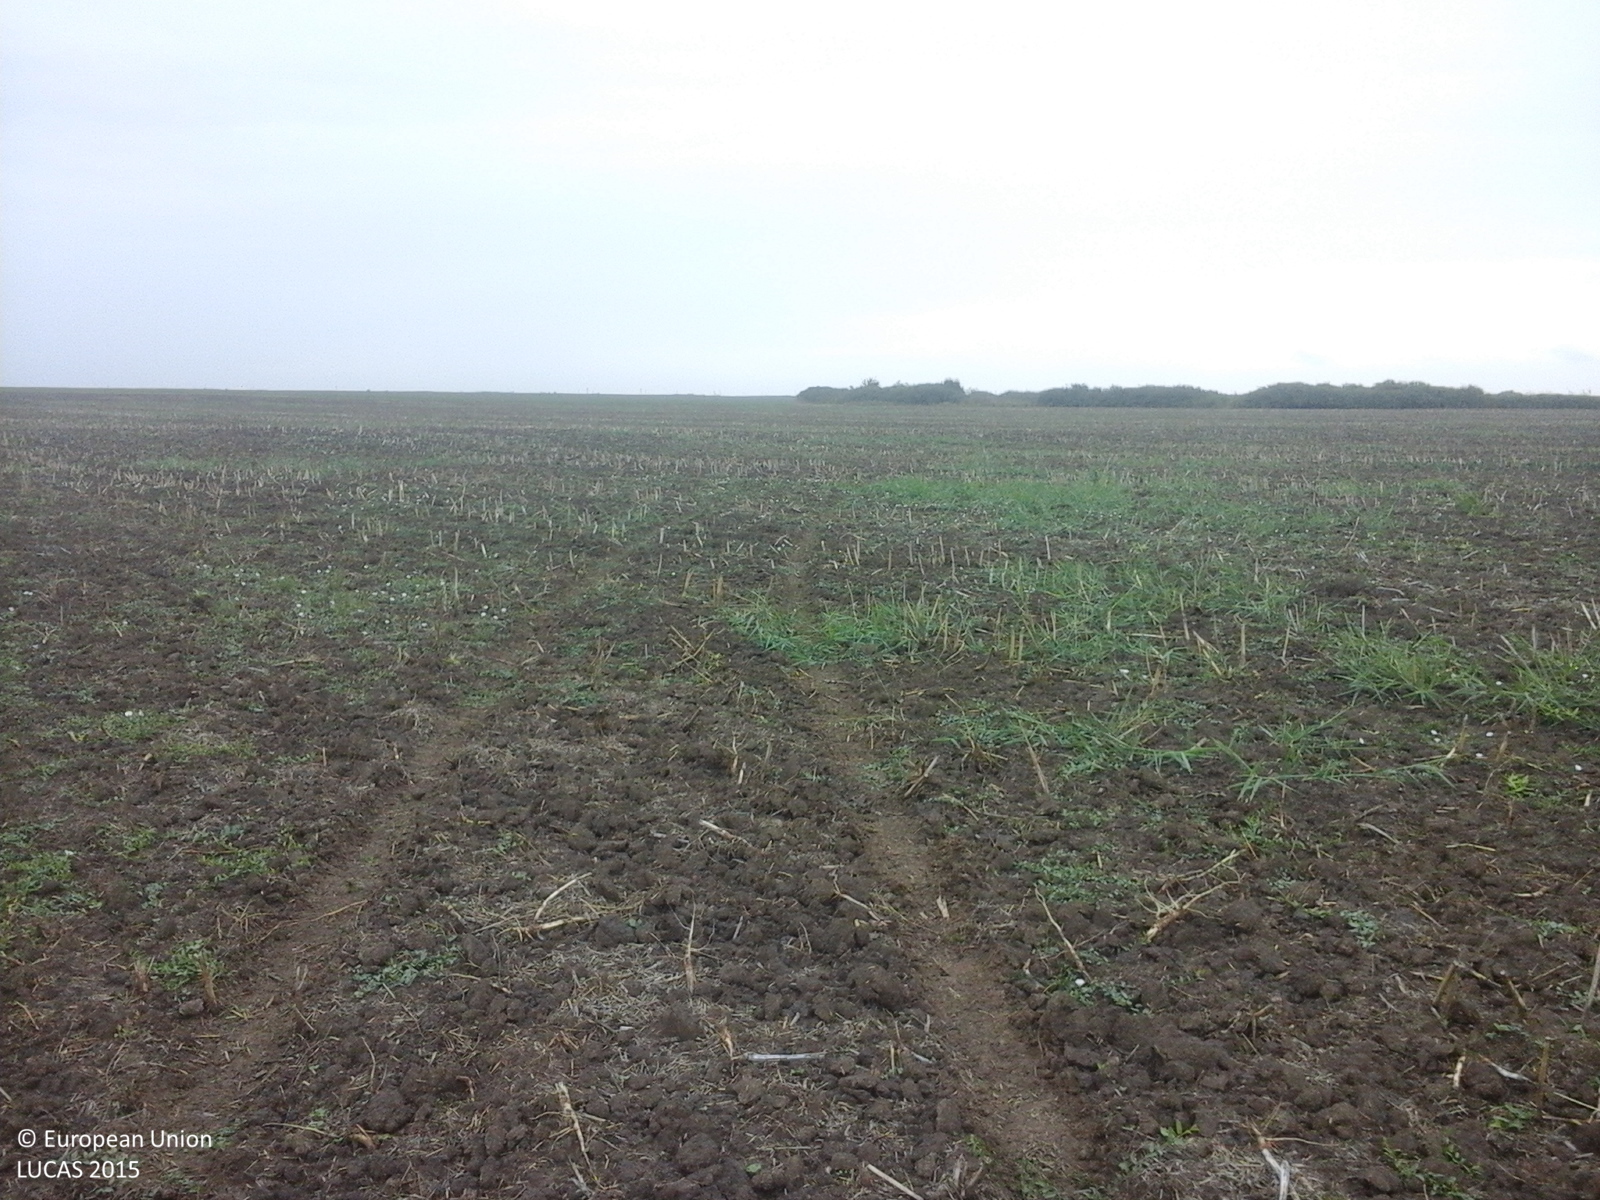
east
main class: Cropland
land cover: Rape and turnip rape
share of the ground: < 10 %
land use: Agriculture (excluding fallow land and kitchen gardens)
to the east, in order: Rape and turnip rape
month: August
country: RO
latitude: 45.4209
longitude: 20.9782
